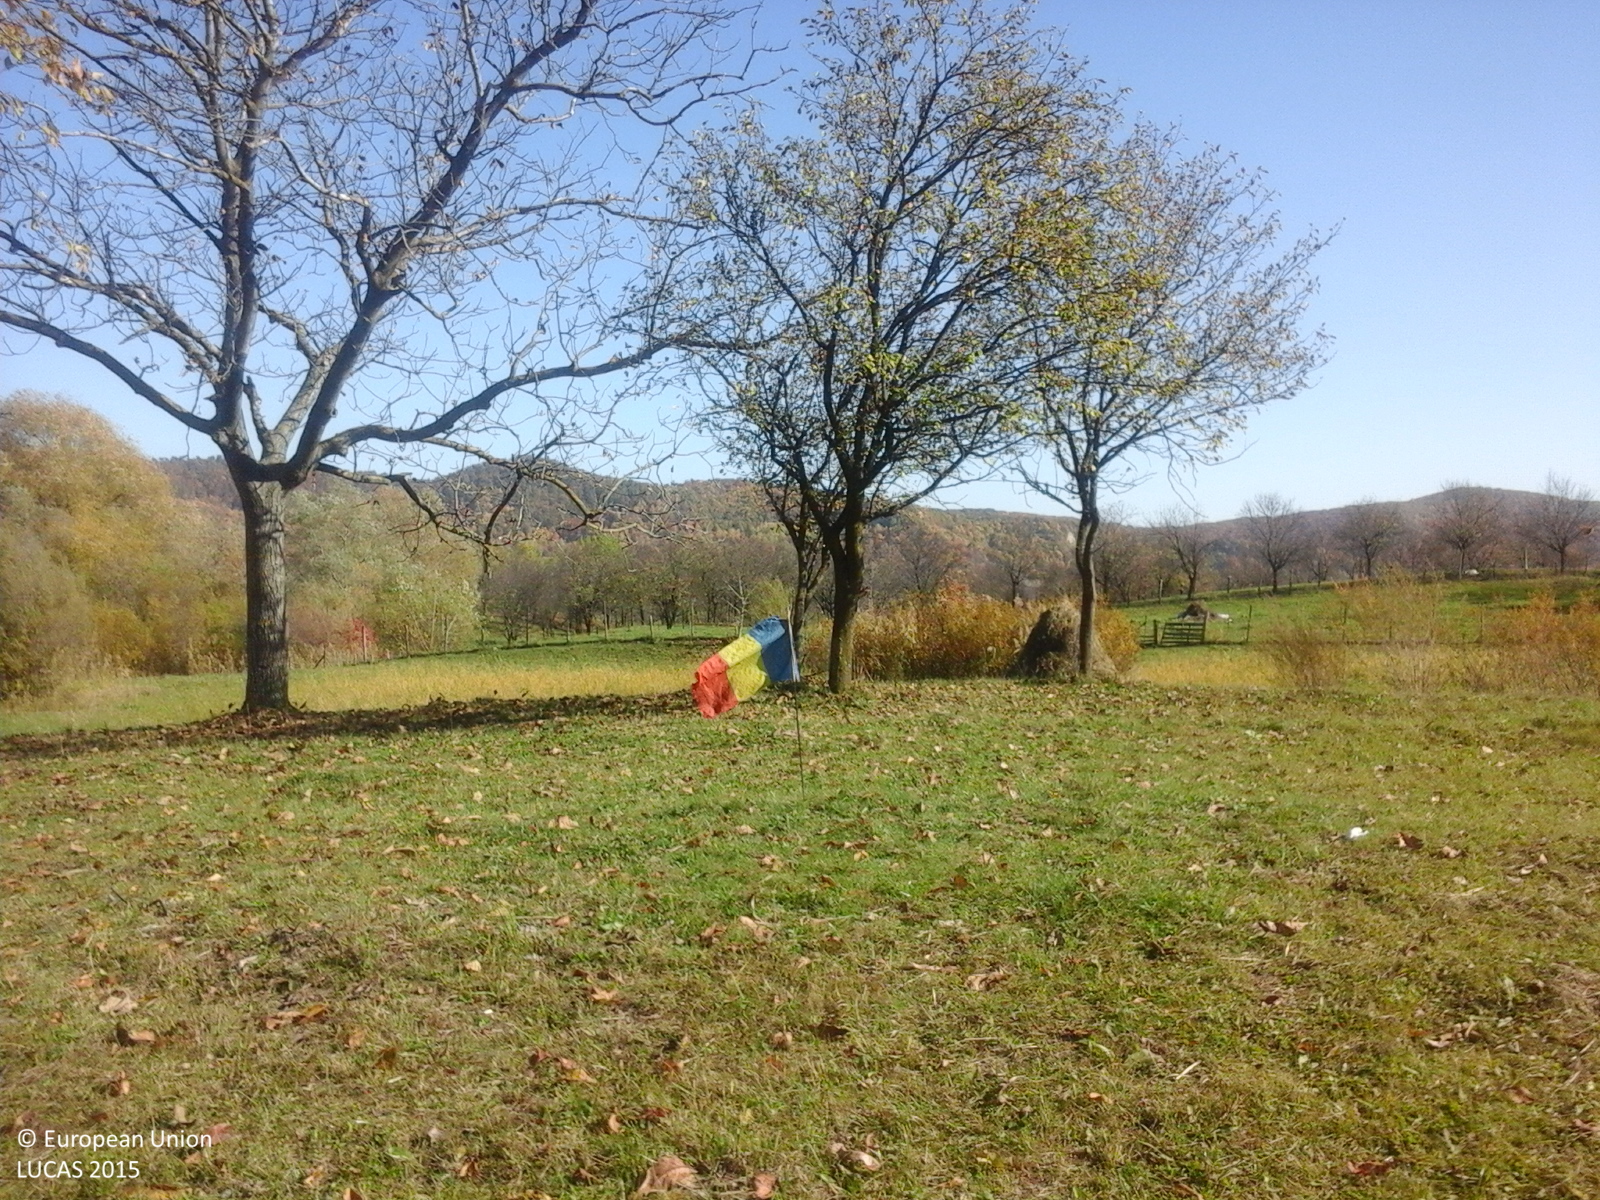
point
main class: Cropland
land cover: Other fruit trees and berries
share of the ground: 25 - 50 %
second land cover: Grassland without tree/shrub cover
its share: > 75 %
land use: Agriculture (excluding fallow land and kitchen gardens)
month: October
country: RO
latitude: 45.4833
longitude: 26.8302
